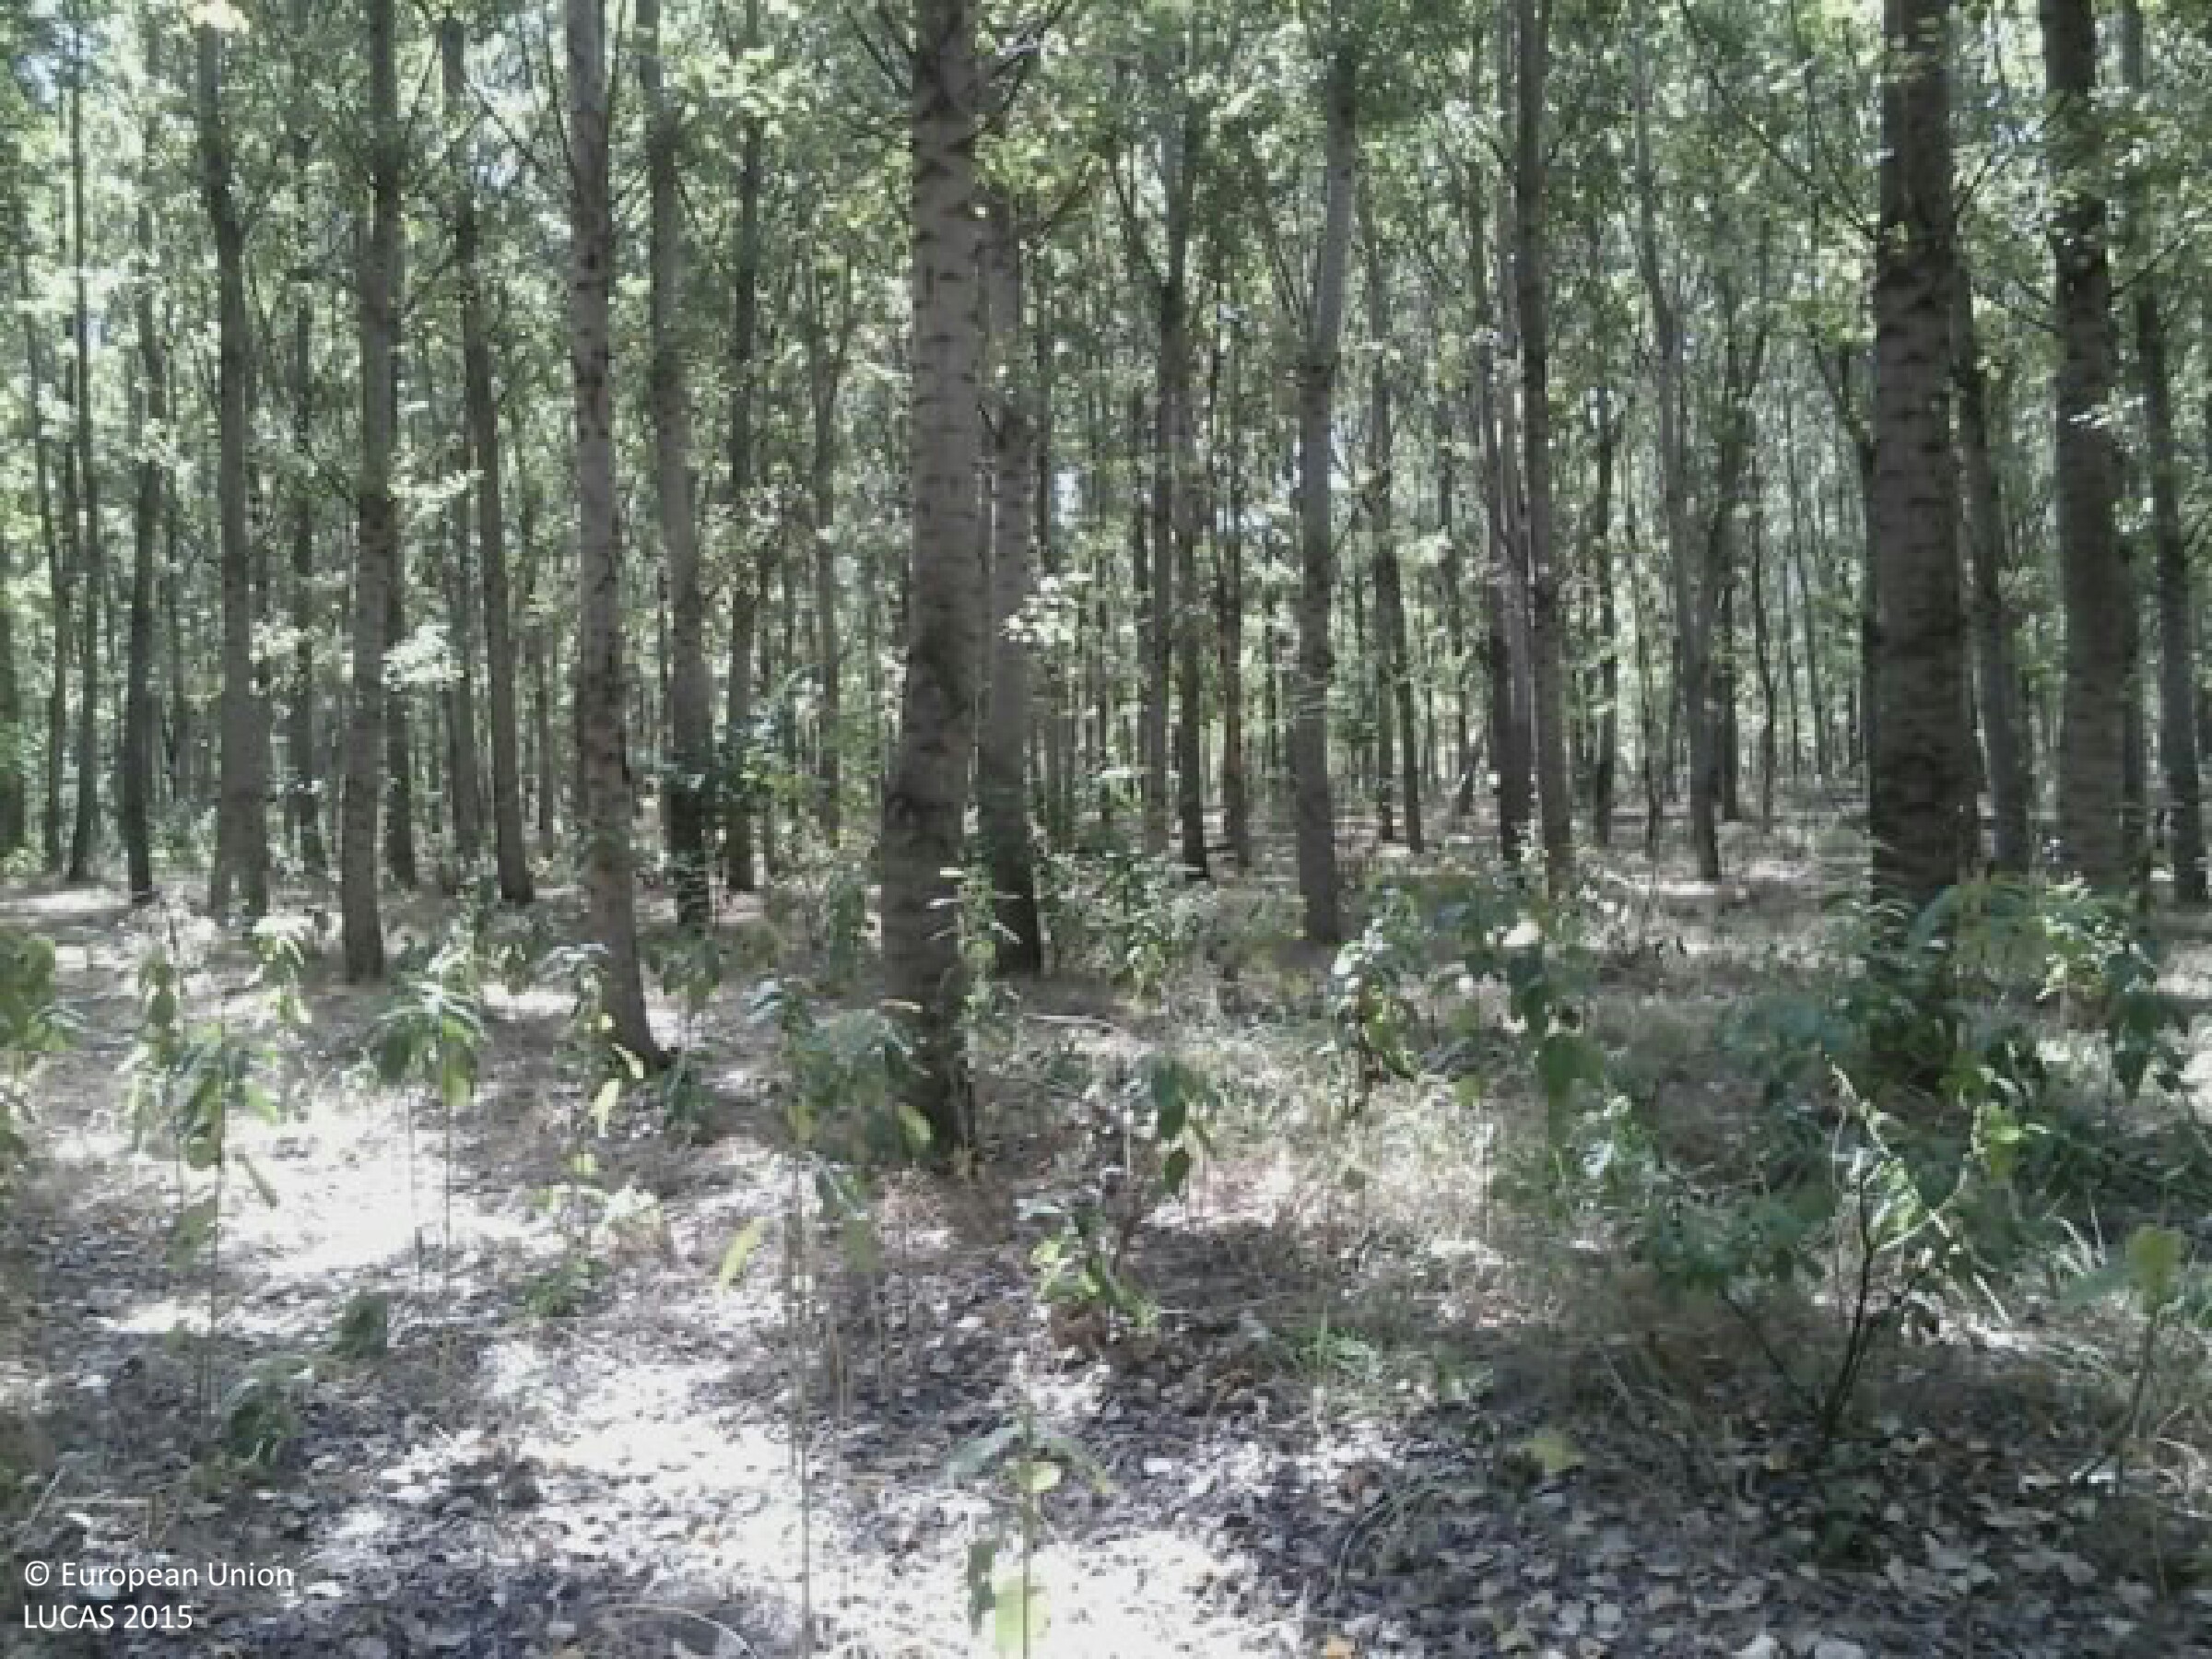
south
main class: Woodland
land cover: Broadleaved woodland
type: mesophytic deciduous forest
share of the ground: > 75 %
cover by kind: broadleaved forest trees 85 %, herbaceous plants 10 %, shrubs 5 %
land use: Forestry
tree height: > 5 m
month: August
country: HU
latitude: 46.9843
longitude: 19.8434
